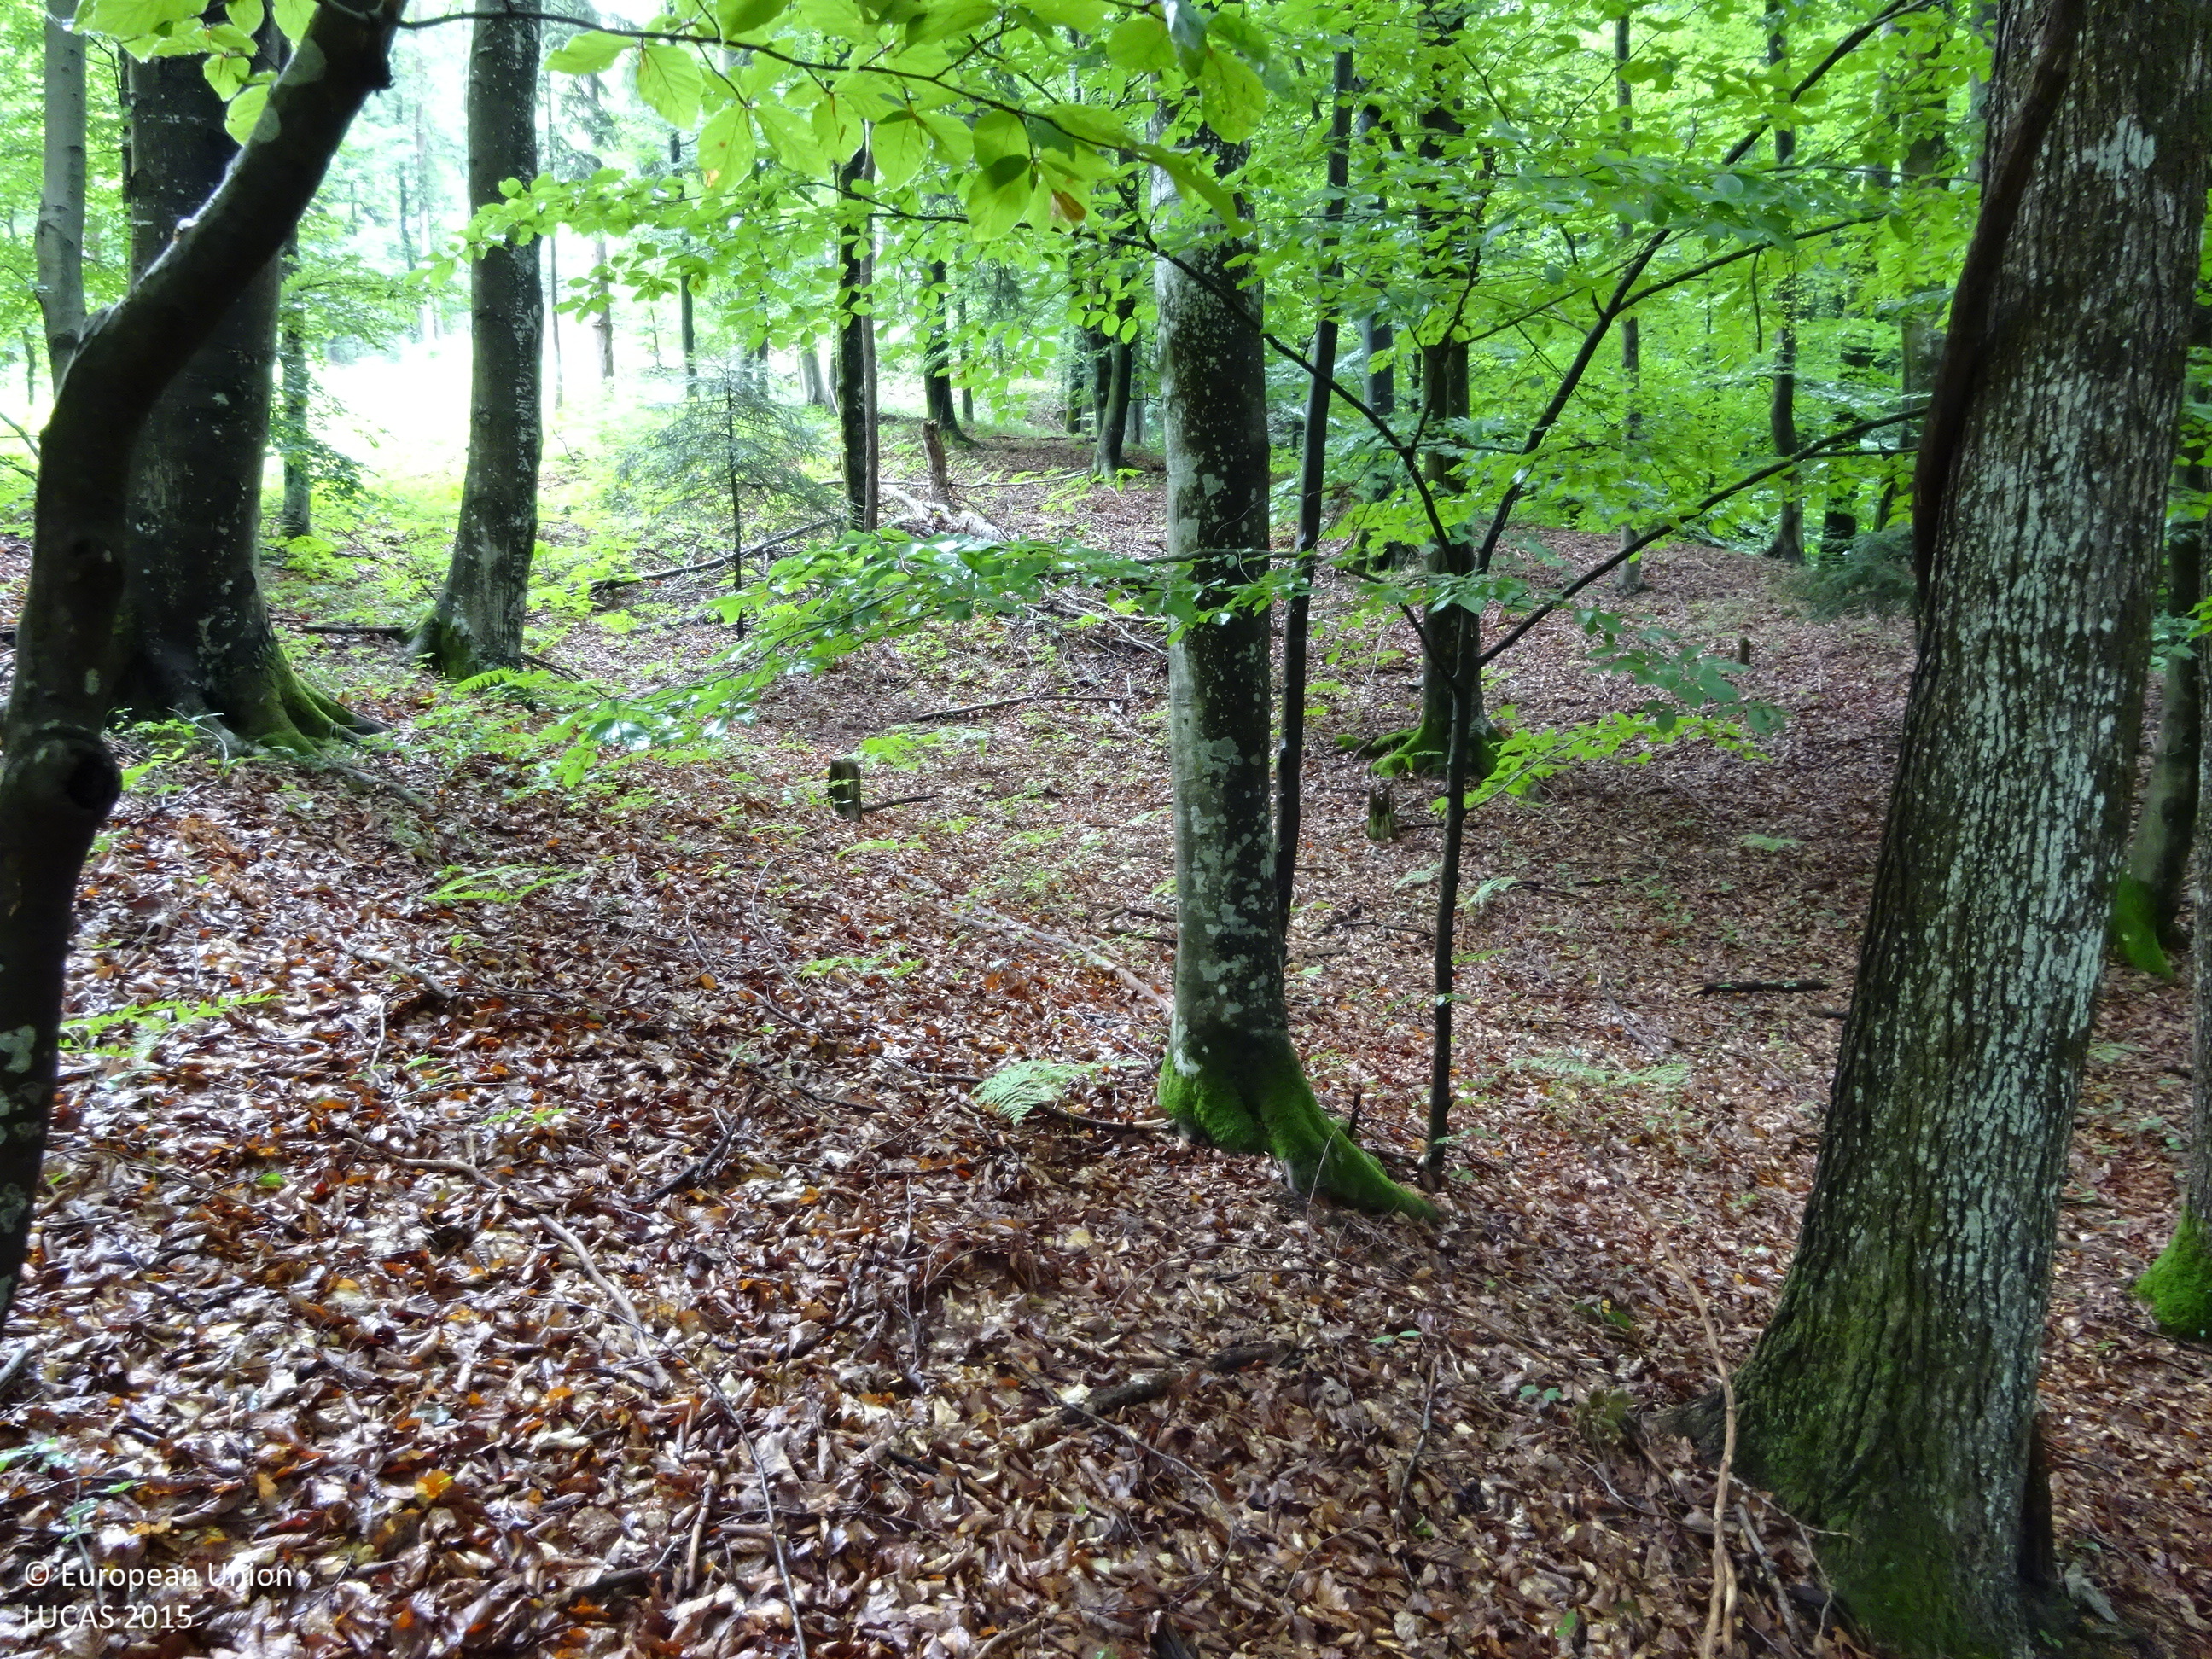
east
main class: Woodland
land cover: Broadleaved woodland
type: mountainous beech forest
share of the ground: > 75 %
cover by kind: broadleaved forest trees 90 %, unconsolidated bare surface 10 %
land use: Forestry
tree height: > 5 m
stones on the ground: < 10 %
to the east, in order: Broadleaved woodland; Spruce dominated mixed woodland; Tracks; Spruce dominated mixed woodland; Grassland without tree/shrub cover
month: June
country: AT
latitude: 46.7008
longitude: 15.4266
